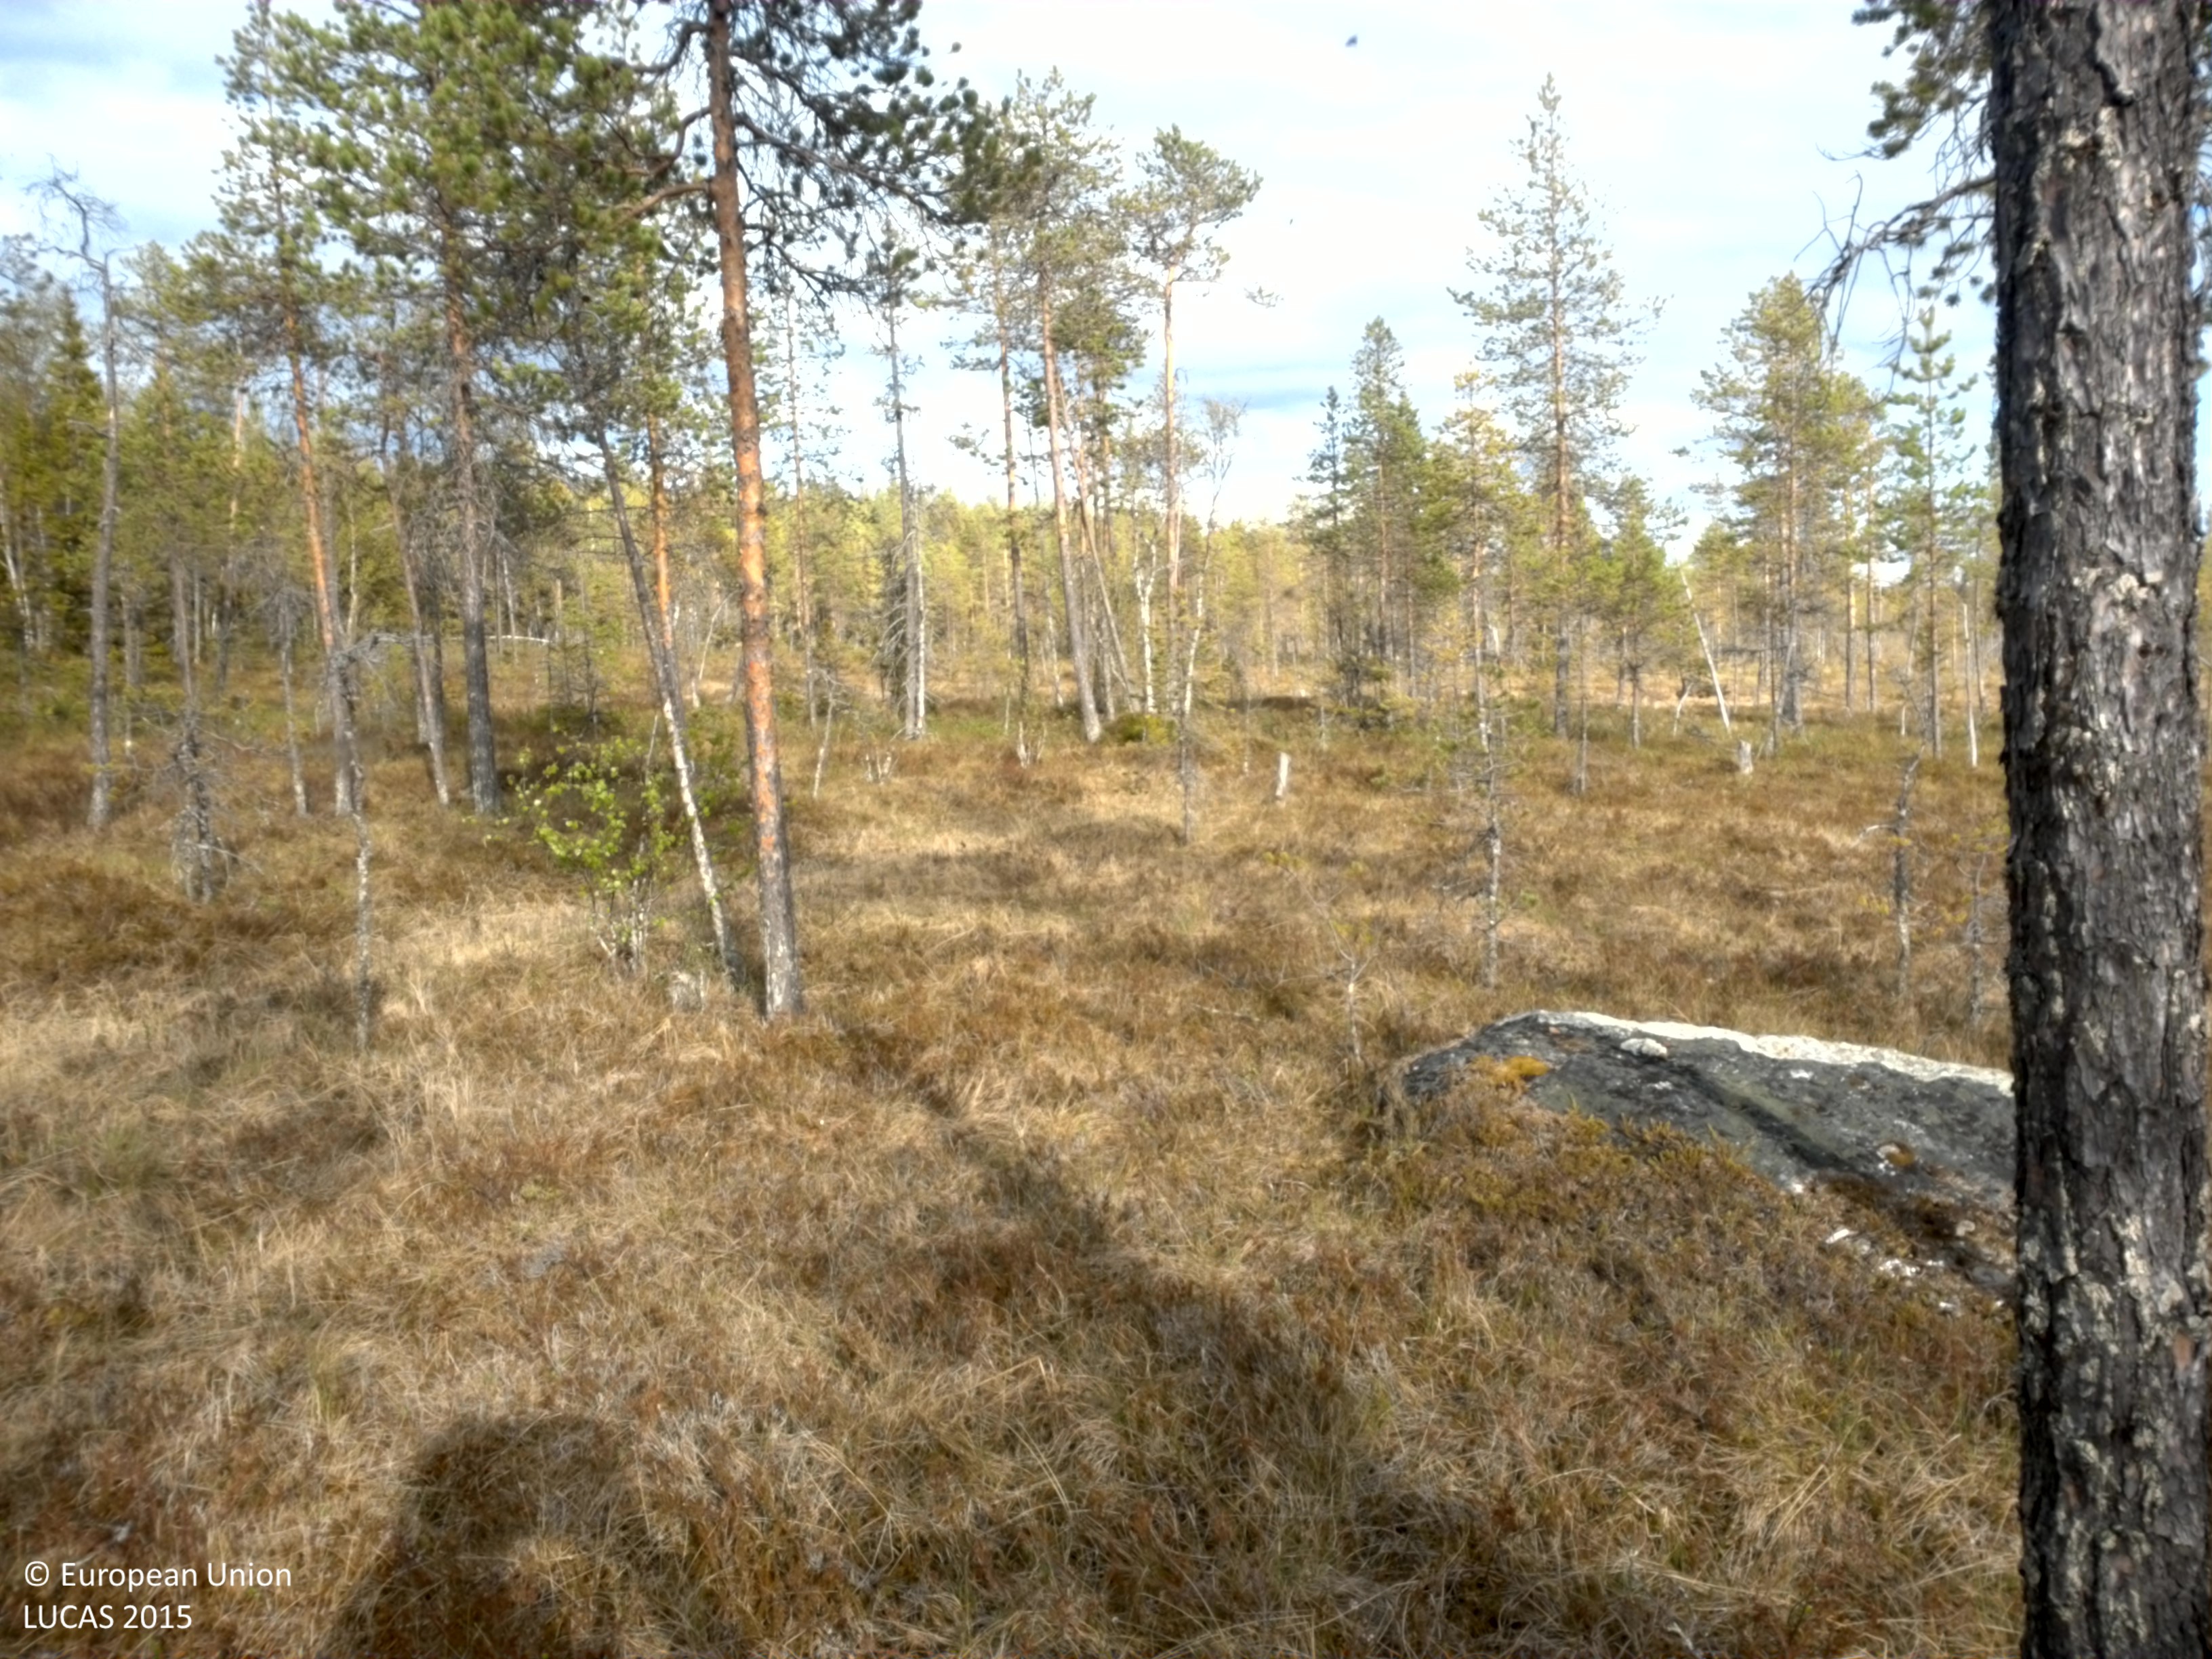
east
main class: Woodland
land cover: Pine dominated coniferous woodland
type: boreal forest
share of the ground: 25 - 50 %
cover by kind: herbaceous plants 45 %, coniferous forest trees 20 %, shrubs 15 %, lichens and mosses 10 %, broadleaved forest trees 5 %, unconsolidated bare surface 5 %
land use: Forestry
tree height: < 5 m
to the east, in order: Pine dominated coniferous woodland; Spruce dominated coniferous woodland; Spruce dominated mixed woodland; Rocks and stones; Broadleaved woodland; Paved roads, cycling and walking lanes; Abandoned hedges; Ditches and canals; Broadleaved woodland
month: June
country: SE
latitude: 64.2052
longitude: 17.4459
